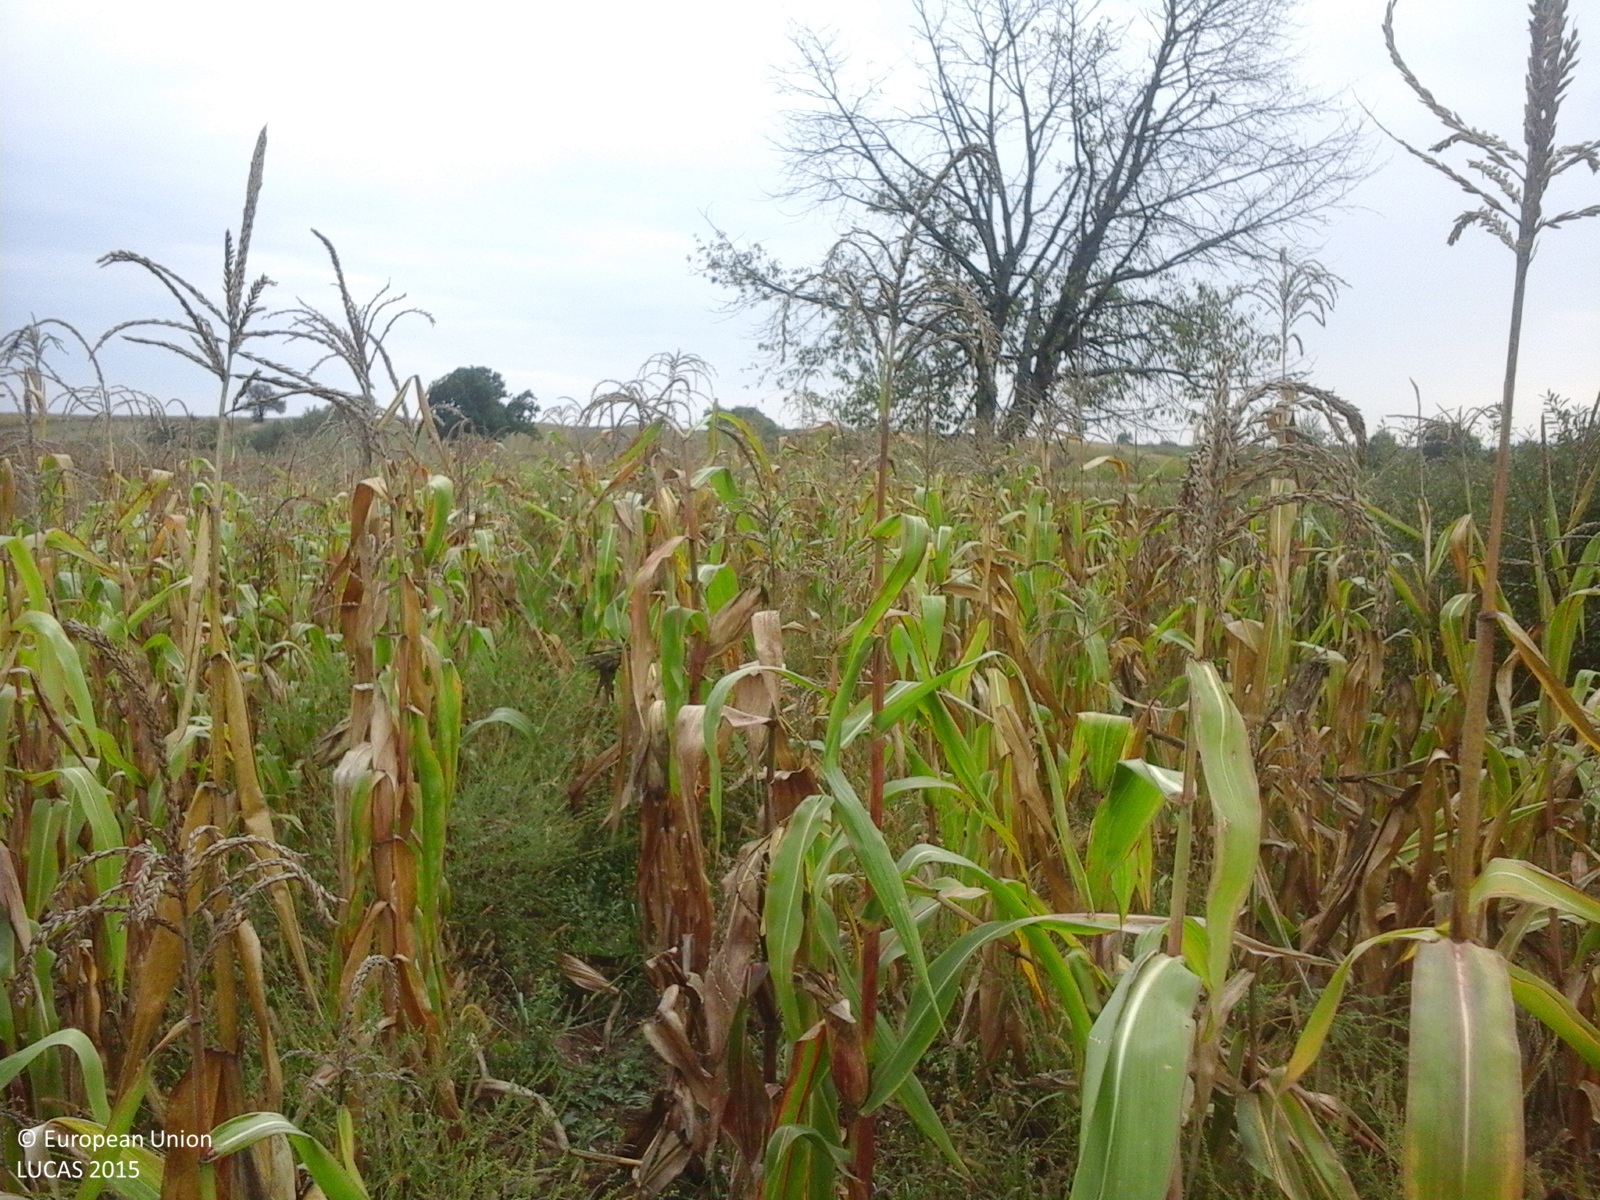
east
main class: Cropland
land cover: Maize
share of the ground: > 75 %
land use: Agriculture (excluding fallow land and kitchen gardens)
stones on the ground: < 10 %
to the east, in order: Maize; Single bushes/trees; Maize; Grassland without tree/shrub cover; Maize; Other fruit trees and berries
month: September
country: RO
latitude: 45.8280
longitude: 22.2340
